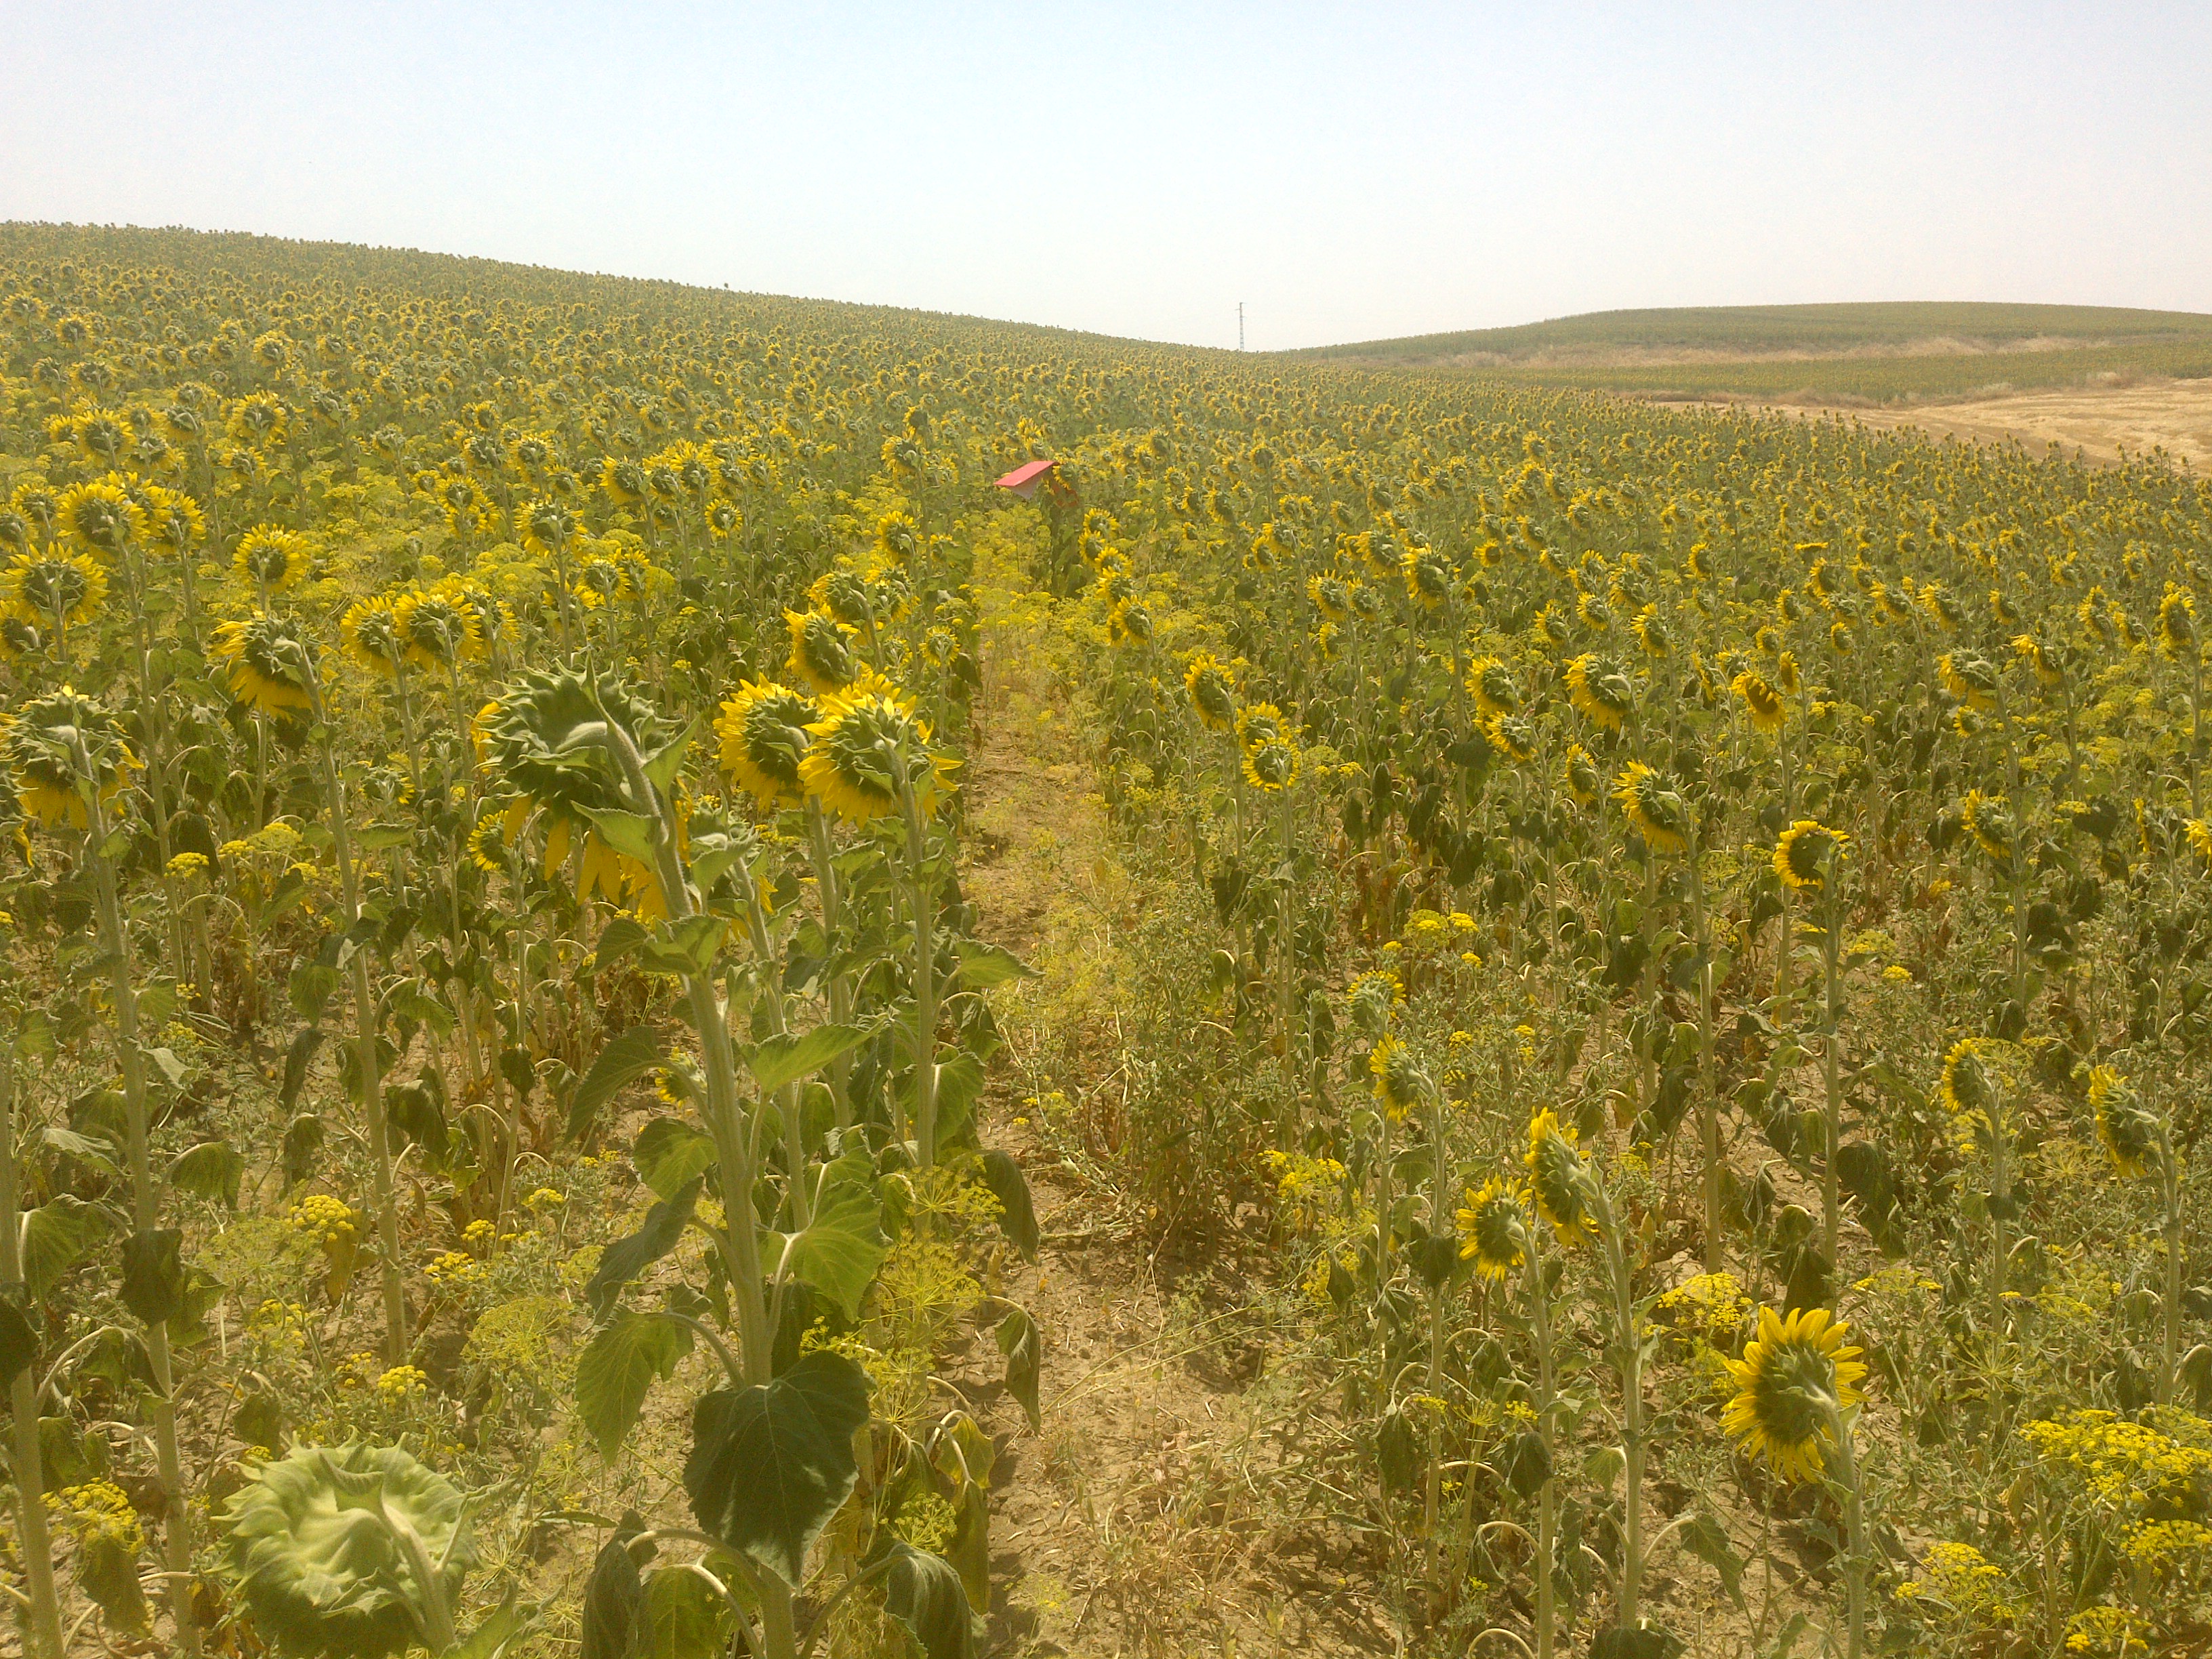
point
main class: Cropland
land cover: Sunflower
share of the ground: > 75 %
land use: Agriculture (excluding fallow land and kitchen gardens)
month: June
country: ES
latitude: 37.7987
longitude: -4.9036
